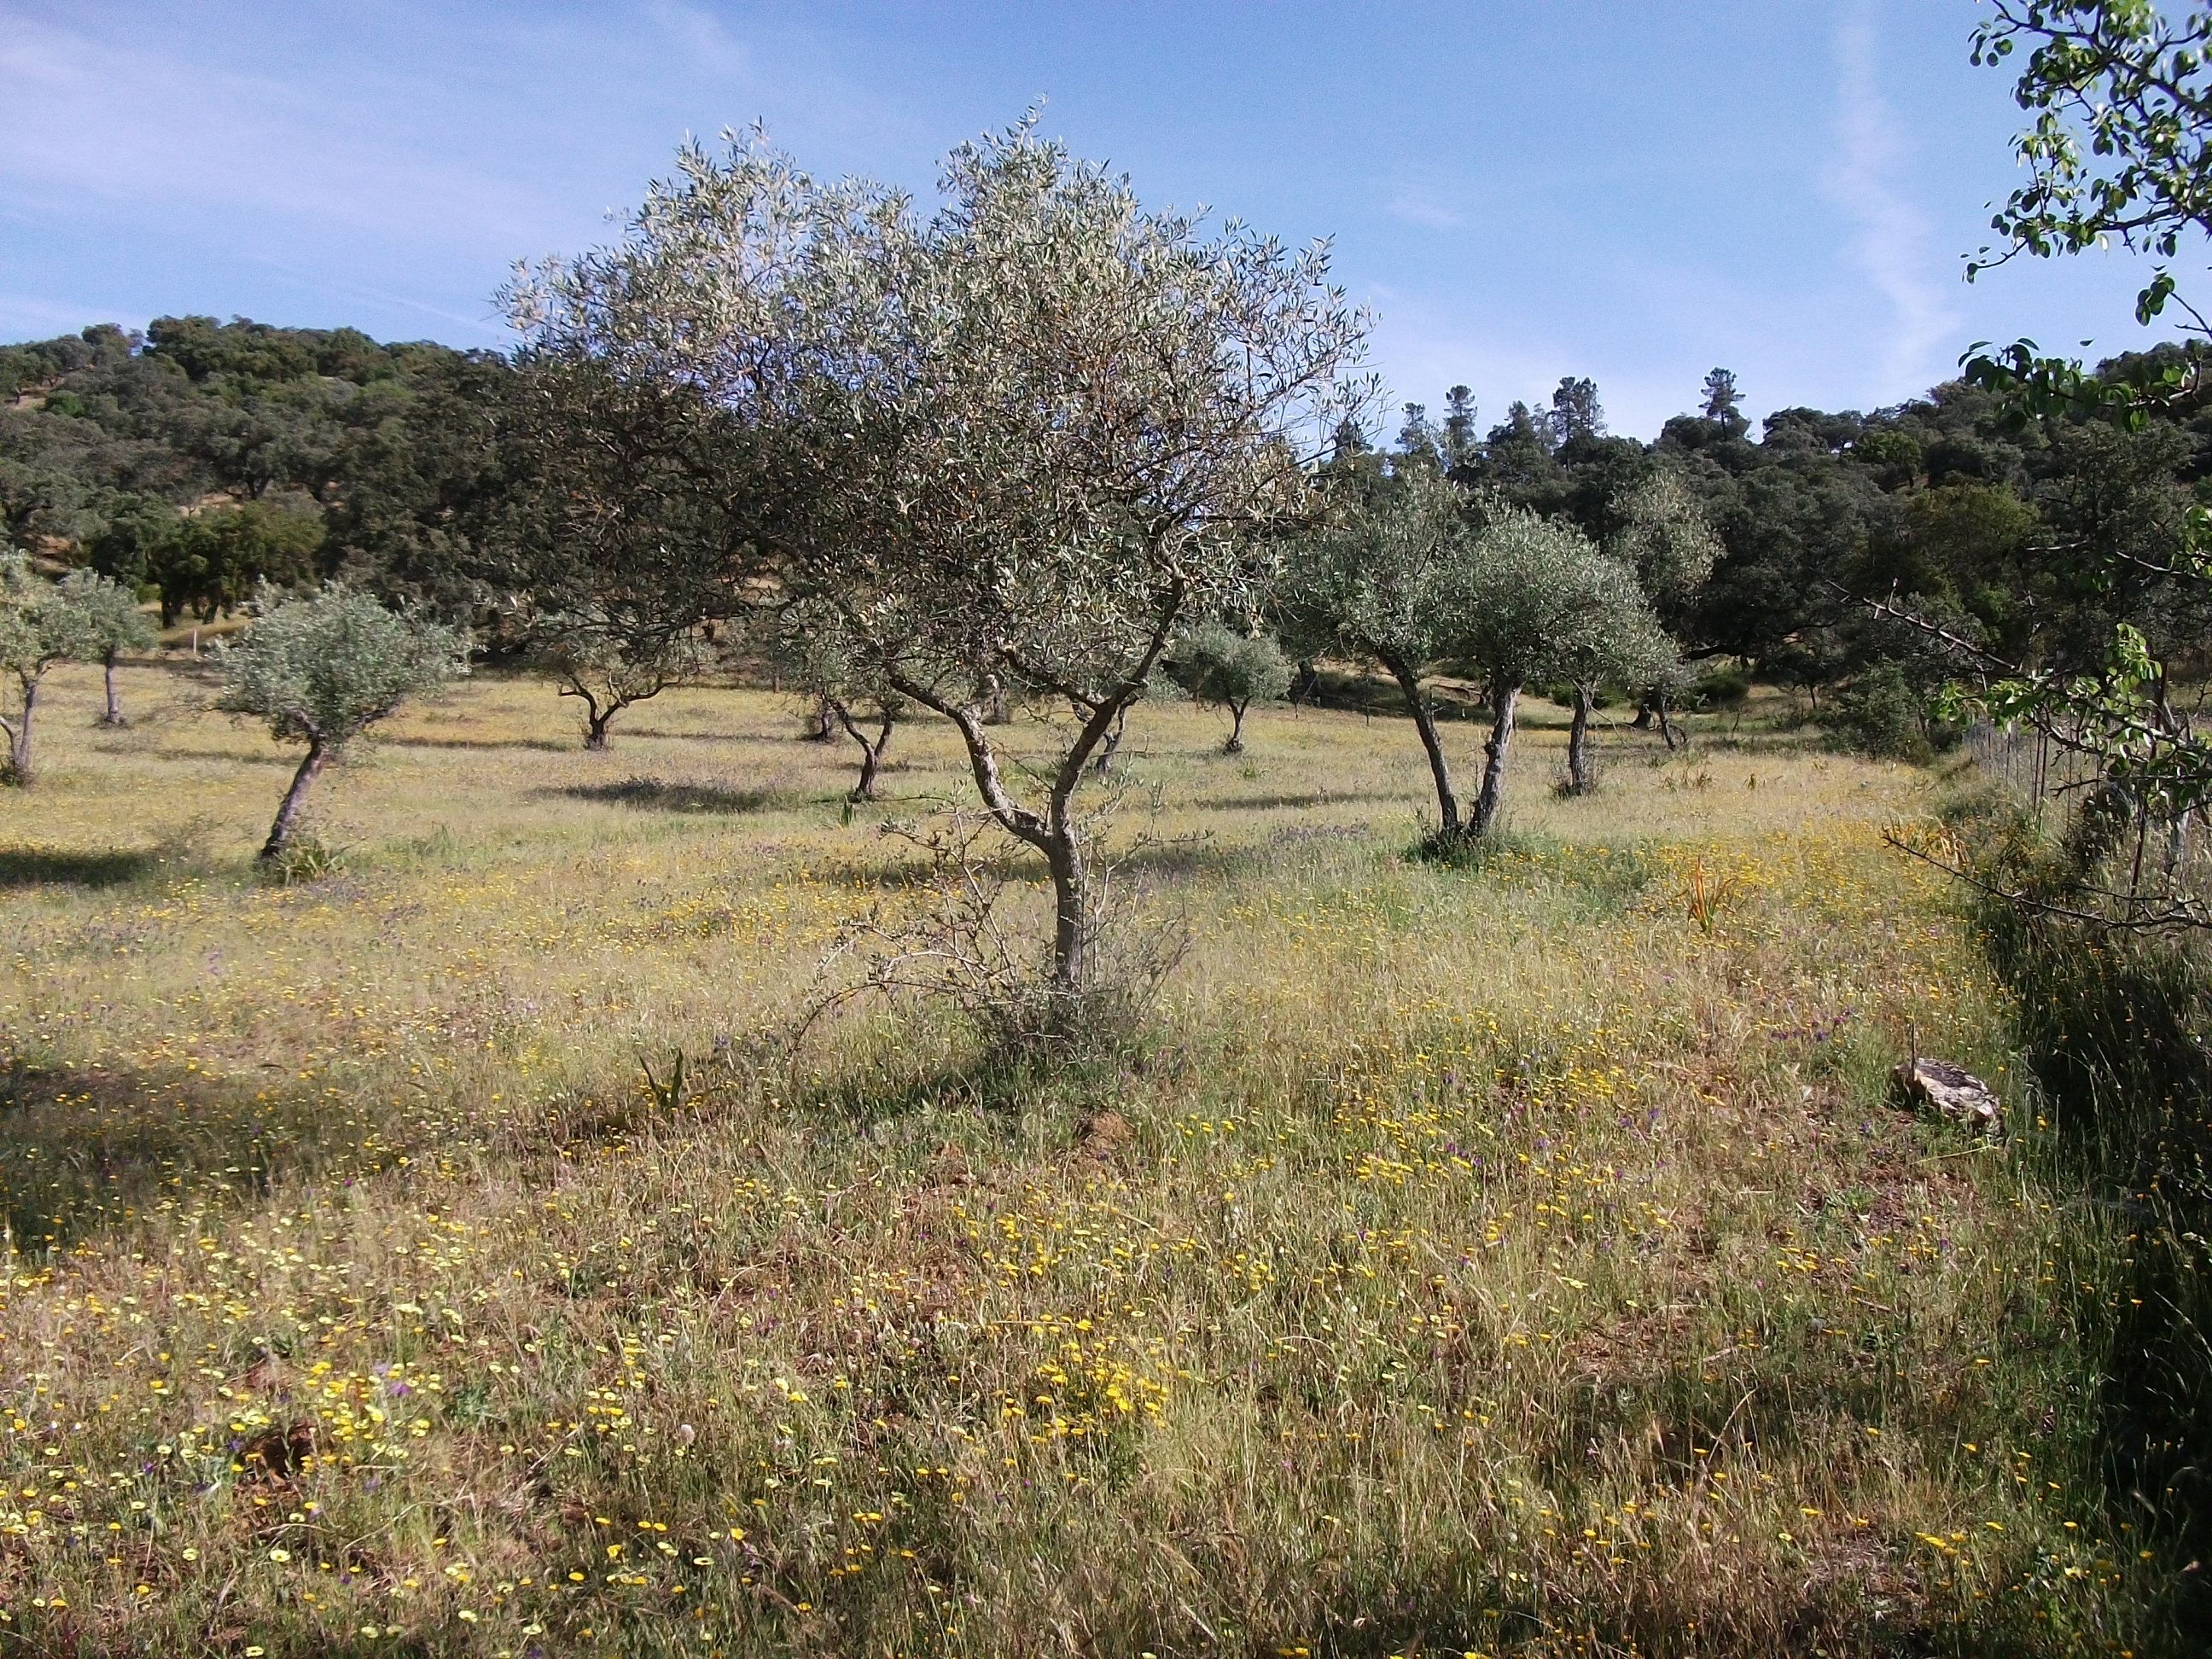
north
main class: Cropland
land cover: Olive groves
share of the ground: 25 - 50 %
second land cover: Spontaneously vegetated surfaces
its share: 50 - 75 %
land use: Agriculture (excluding fallow land and kitchen gardens)
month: May
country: ES
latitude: 37.9719
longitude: -7.2363
